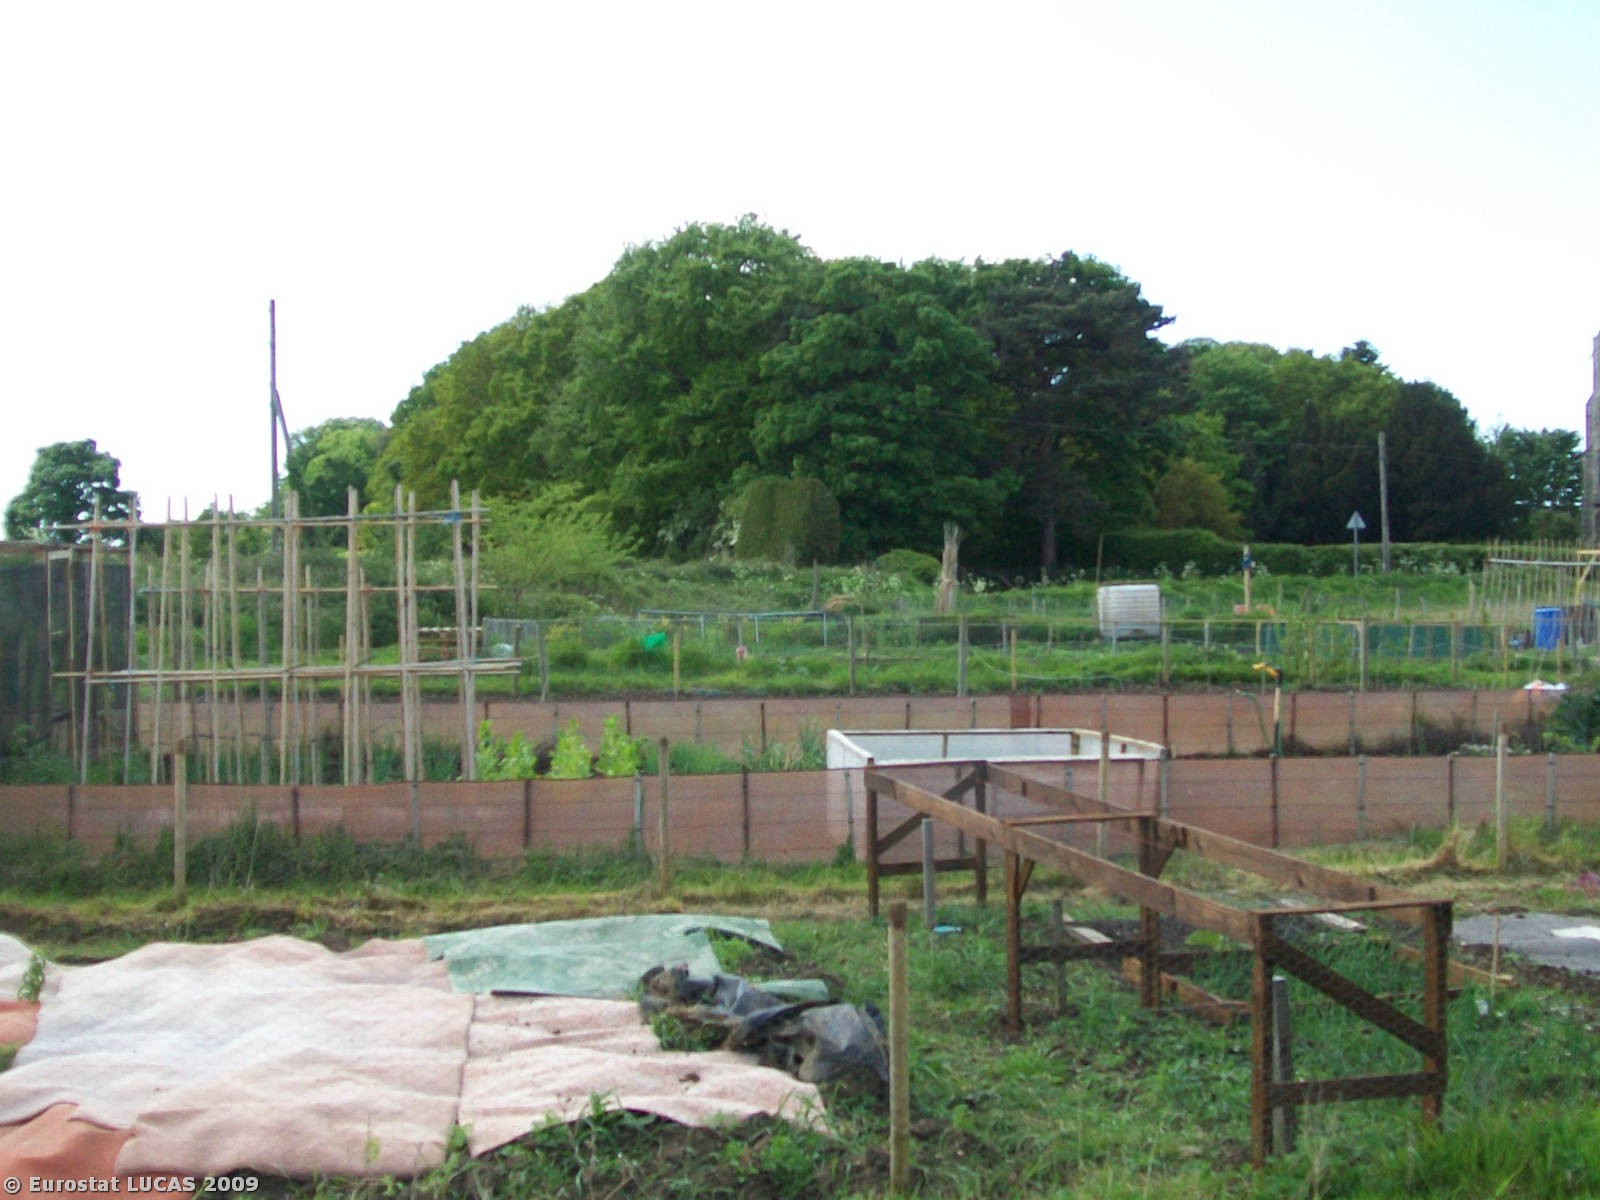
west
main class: Grassland
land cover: Grassland without tree/shrub cover
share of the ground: > 75 %
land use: Fallow land
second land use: Amenities, museums, leisure
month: May
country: GB
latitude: 52.5288
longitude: 1.5646
